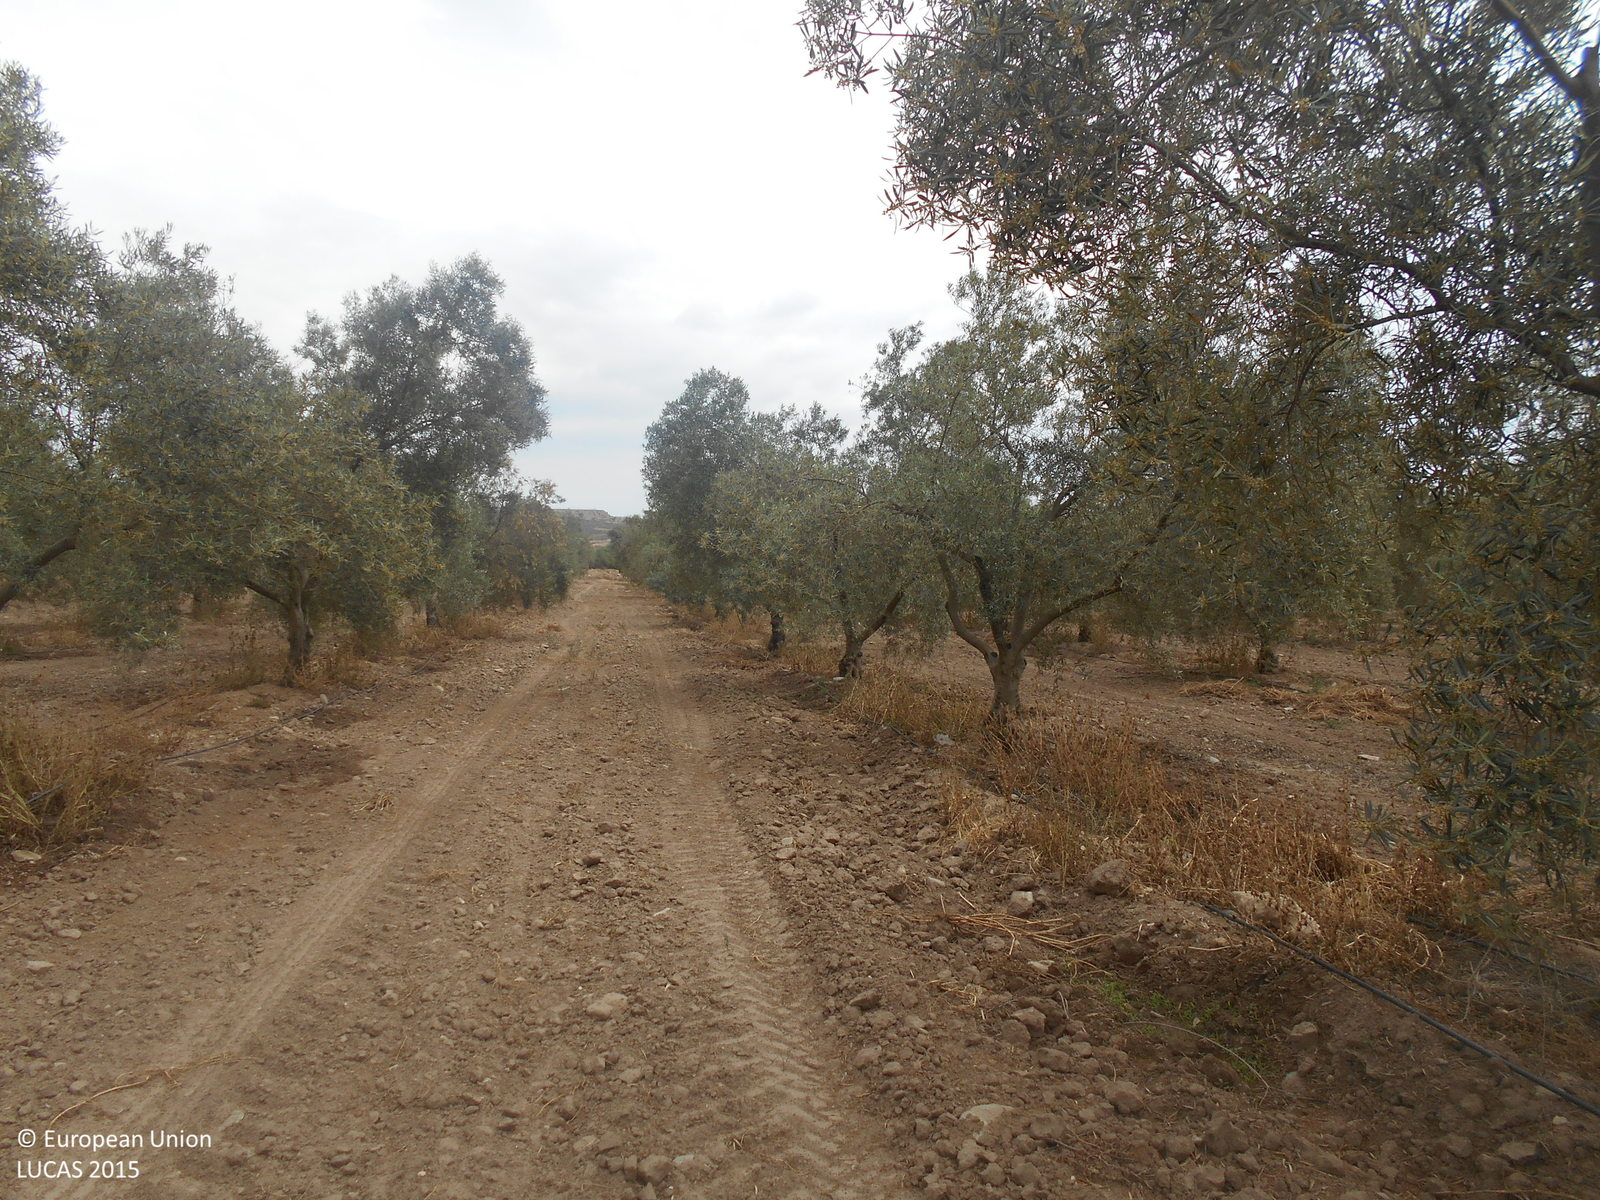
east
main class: Cropland
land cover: Olive groves
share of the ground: 50 - 75 %
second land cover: Other bare soil
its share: > 75 %
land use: Agriculture (excluding fallow land and kitchen gardens)
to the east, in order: Olive groves; Other bare soil; Tracks; Shruby margins; Olive groves
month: May
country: ES
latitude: 37.0927
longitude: -2.2974
